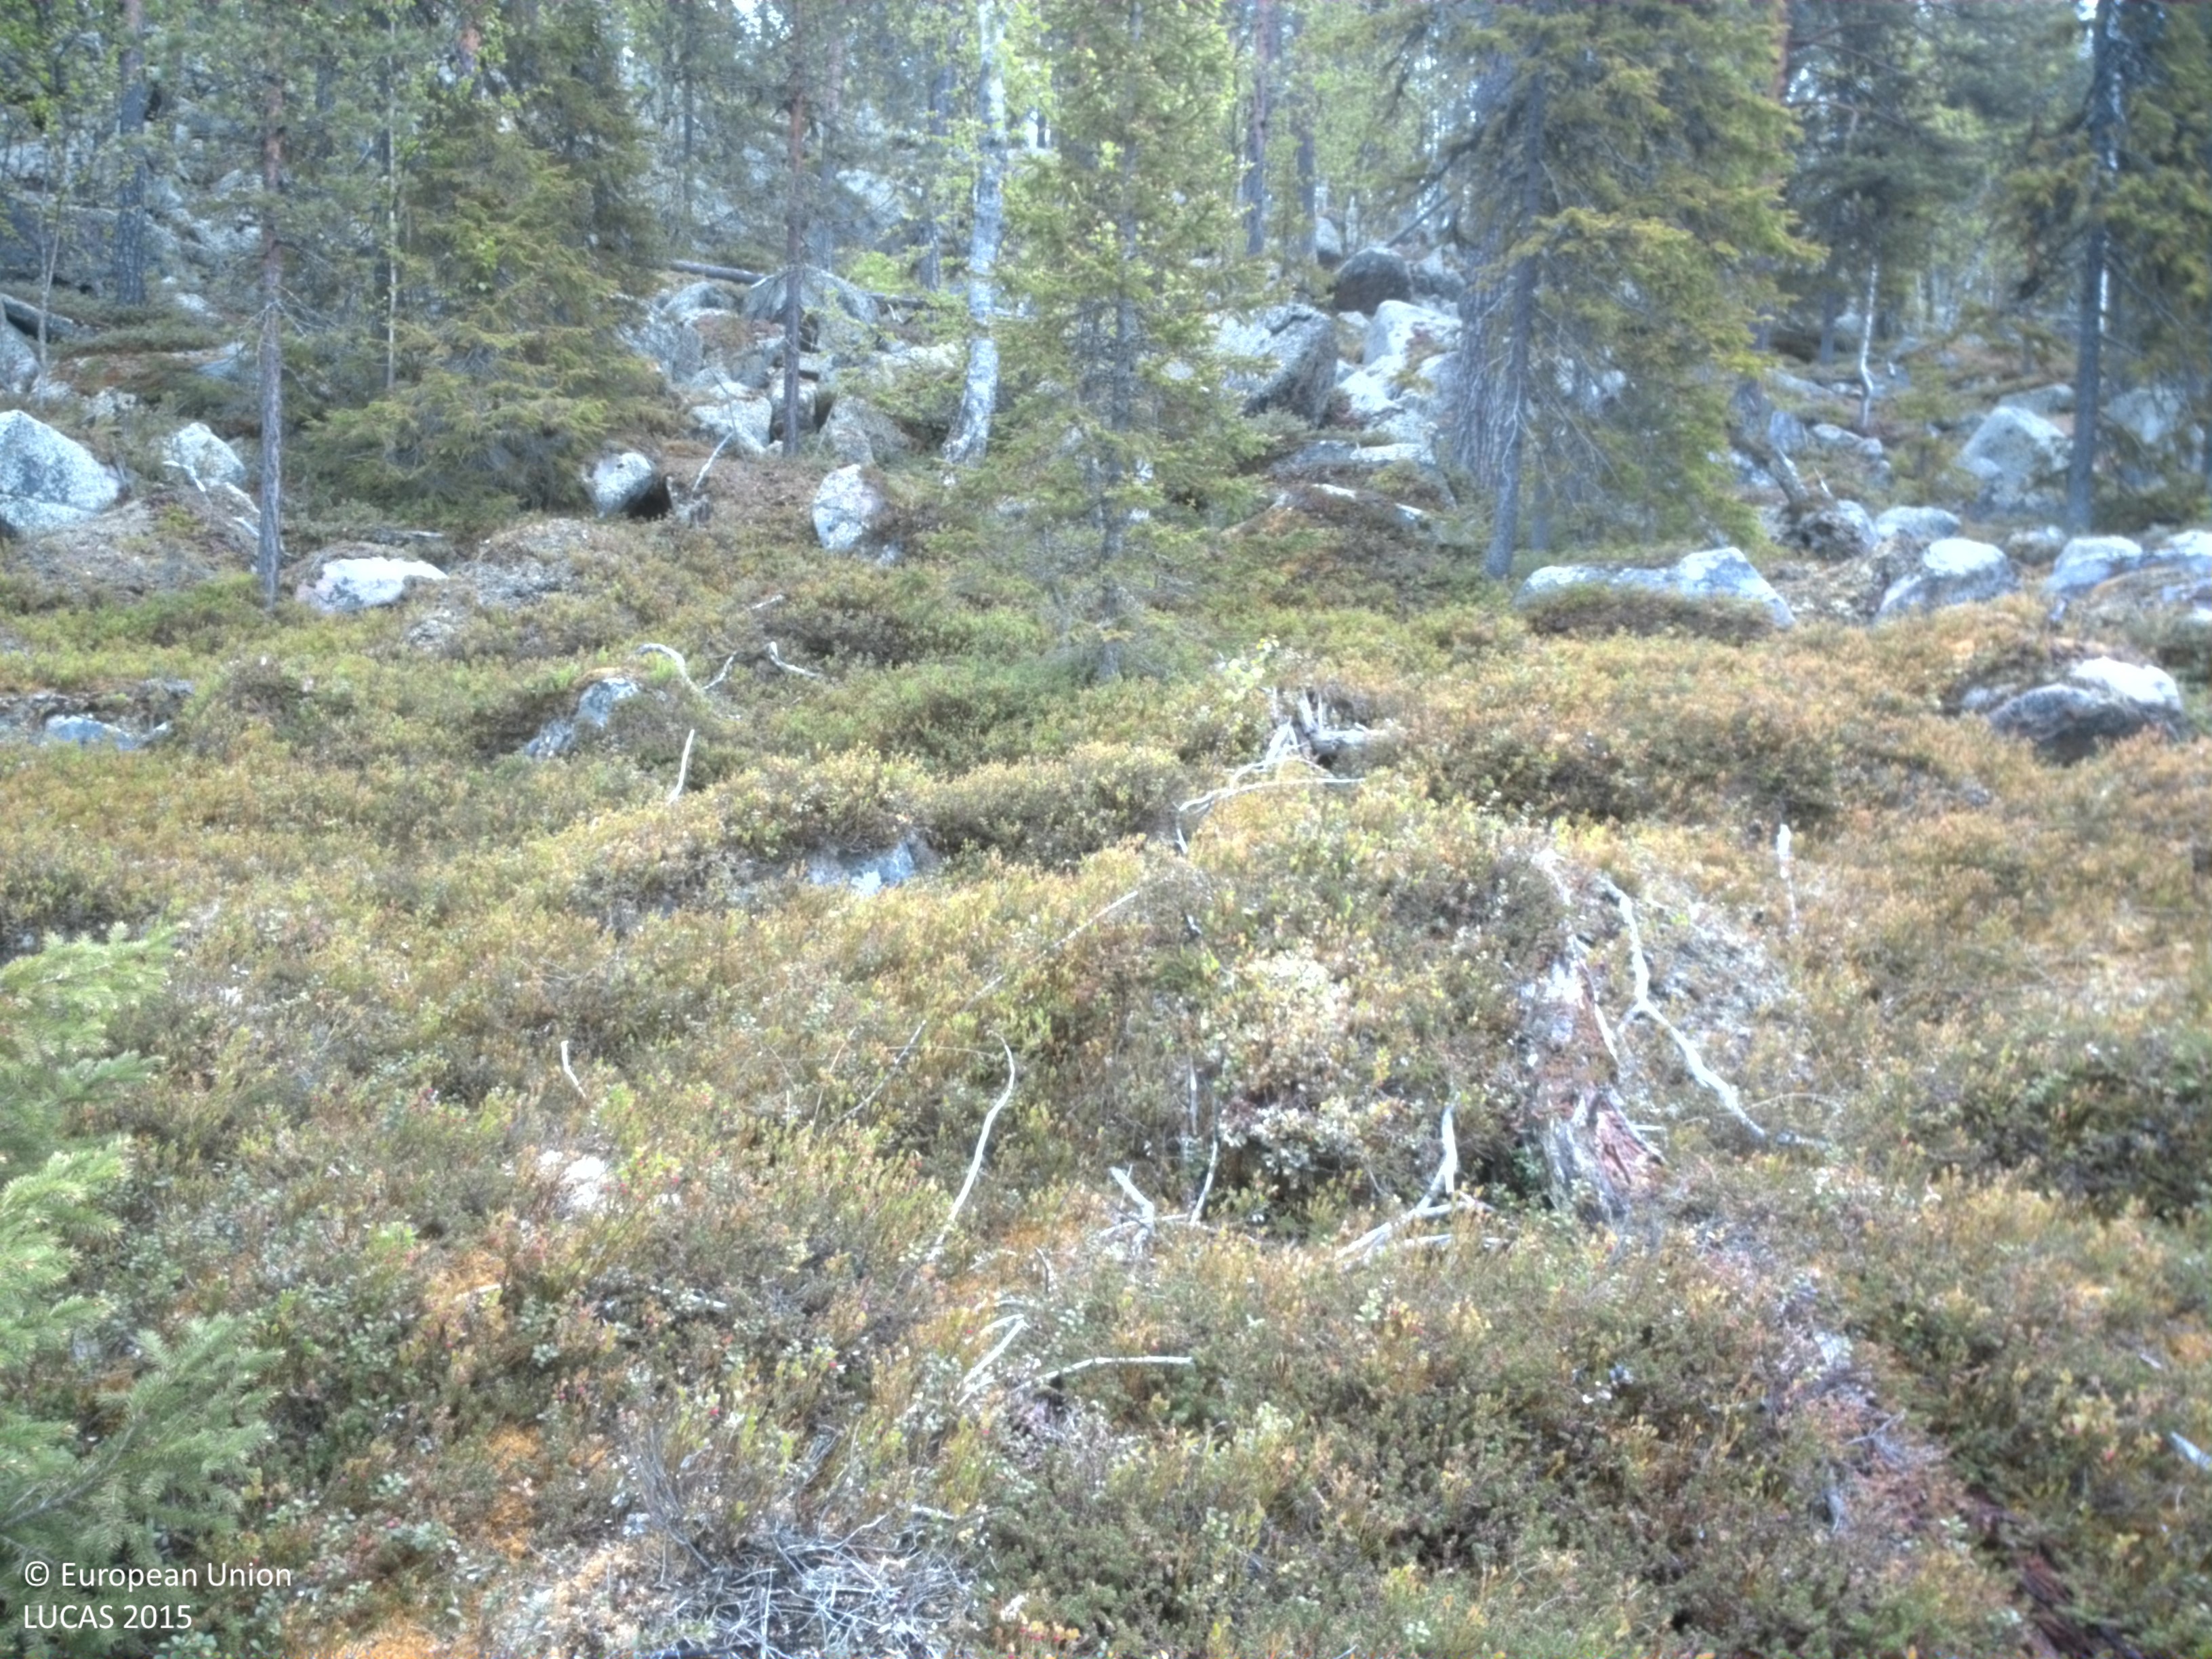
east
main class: Woodland
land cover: Spruce dominated coniferous woodland
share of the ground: 10 - 25 %
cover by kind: herbaceous plants 75 %, coniferous forest trees 10 %, lichens and mosses 10 %, shrubs 5 %
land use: Forestry
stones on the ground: < 10 %
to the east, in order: Spruce dominated coniferous woodland; Pine dominated mixed woodland; Pine dominated coniferous woodland; Pine dominated mixed woodland; Shrubland with sparse tree cover; Pine dominated mixed woodland; Pine dominated coniferous woodland; Pine dominated mixed woodland
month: June
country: SE
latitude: 66.7877
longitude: 22.4496
